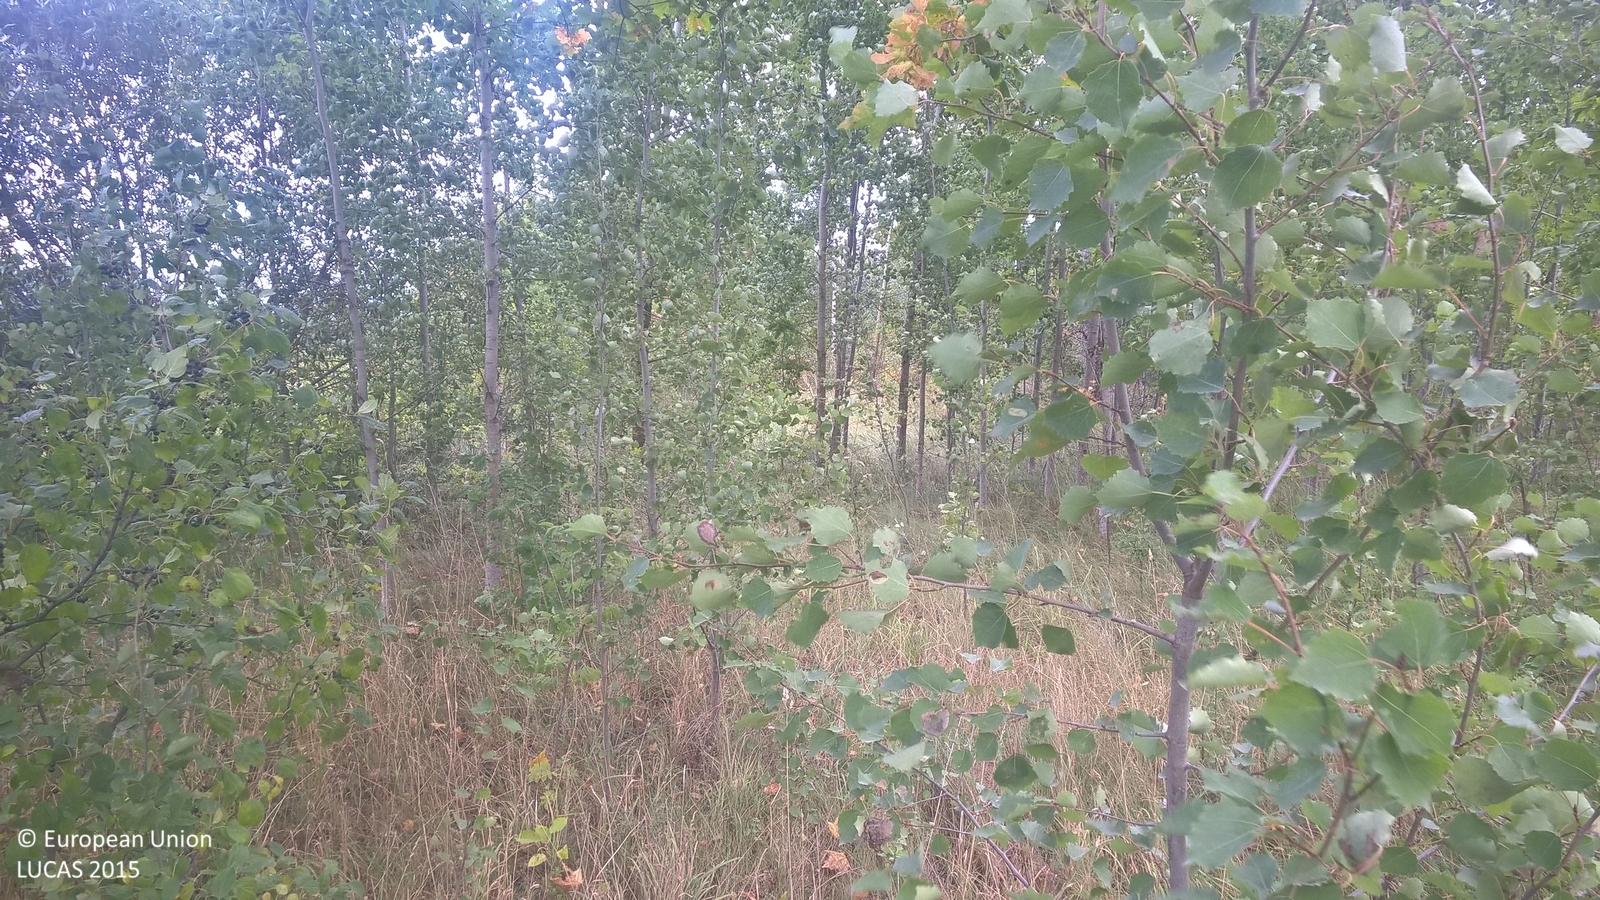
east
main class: Woodland
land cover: Broadleaved woodland
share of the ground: 10 - 25 %
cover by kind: herbaceous plants 70 %, broadleaved forest trees 20 %, shrubs 5 %, lichens and mosses 5 %
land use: Forestry
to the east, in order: Broadleaved woodland; Pine dominated mixed woodland; Grassland without tree/shrub cover; Electric lines; Spontaneously vegetated surfaces; Electric lines; Broadleaved woodland
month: September
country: LV
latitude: 57.4603
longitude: 25.9461
